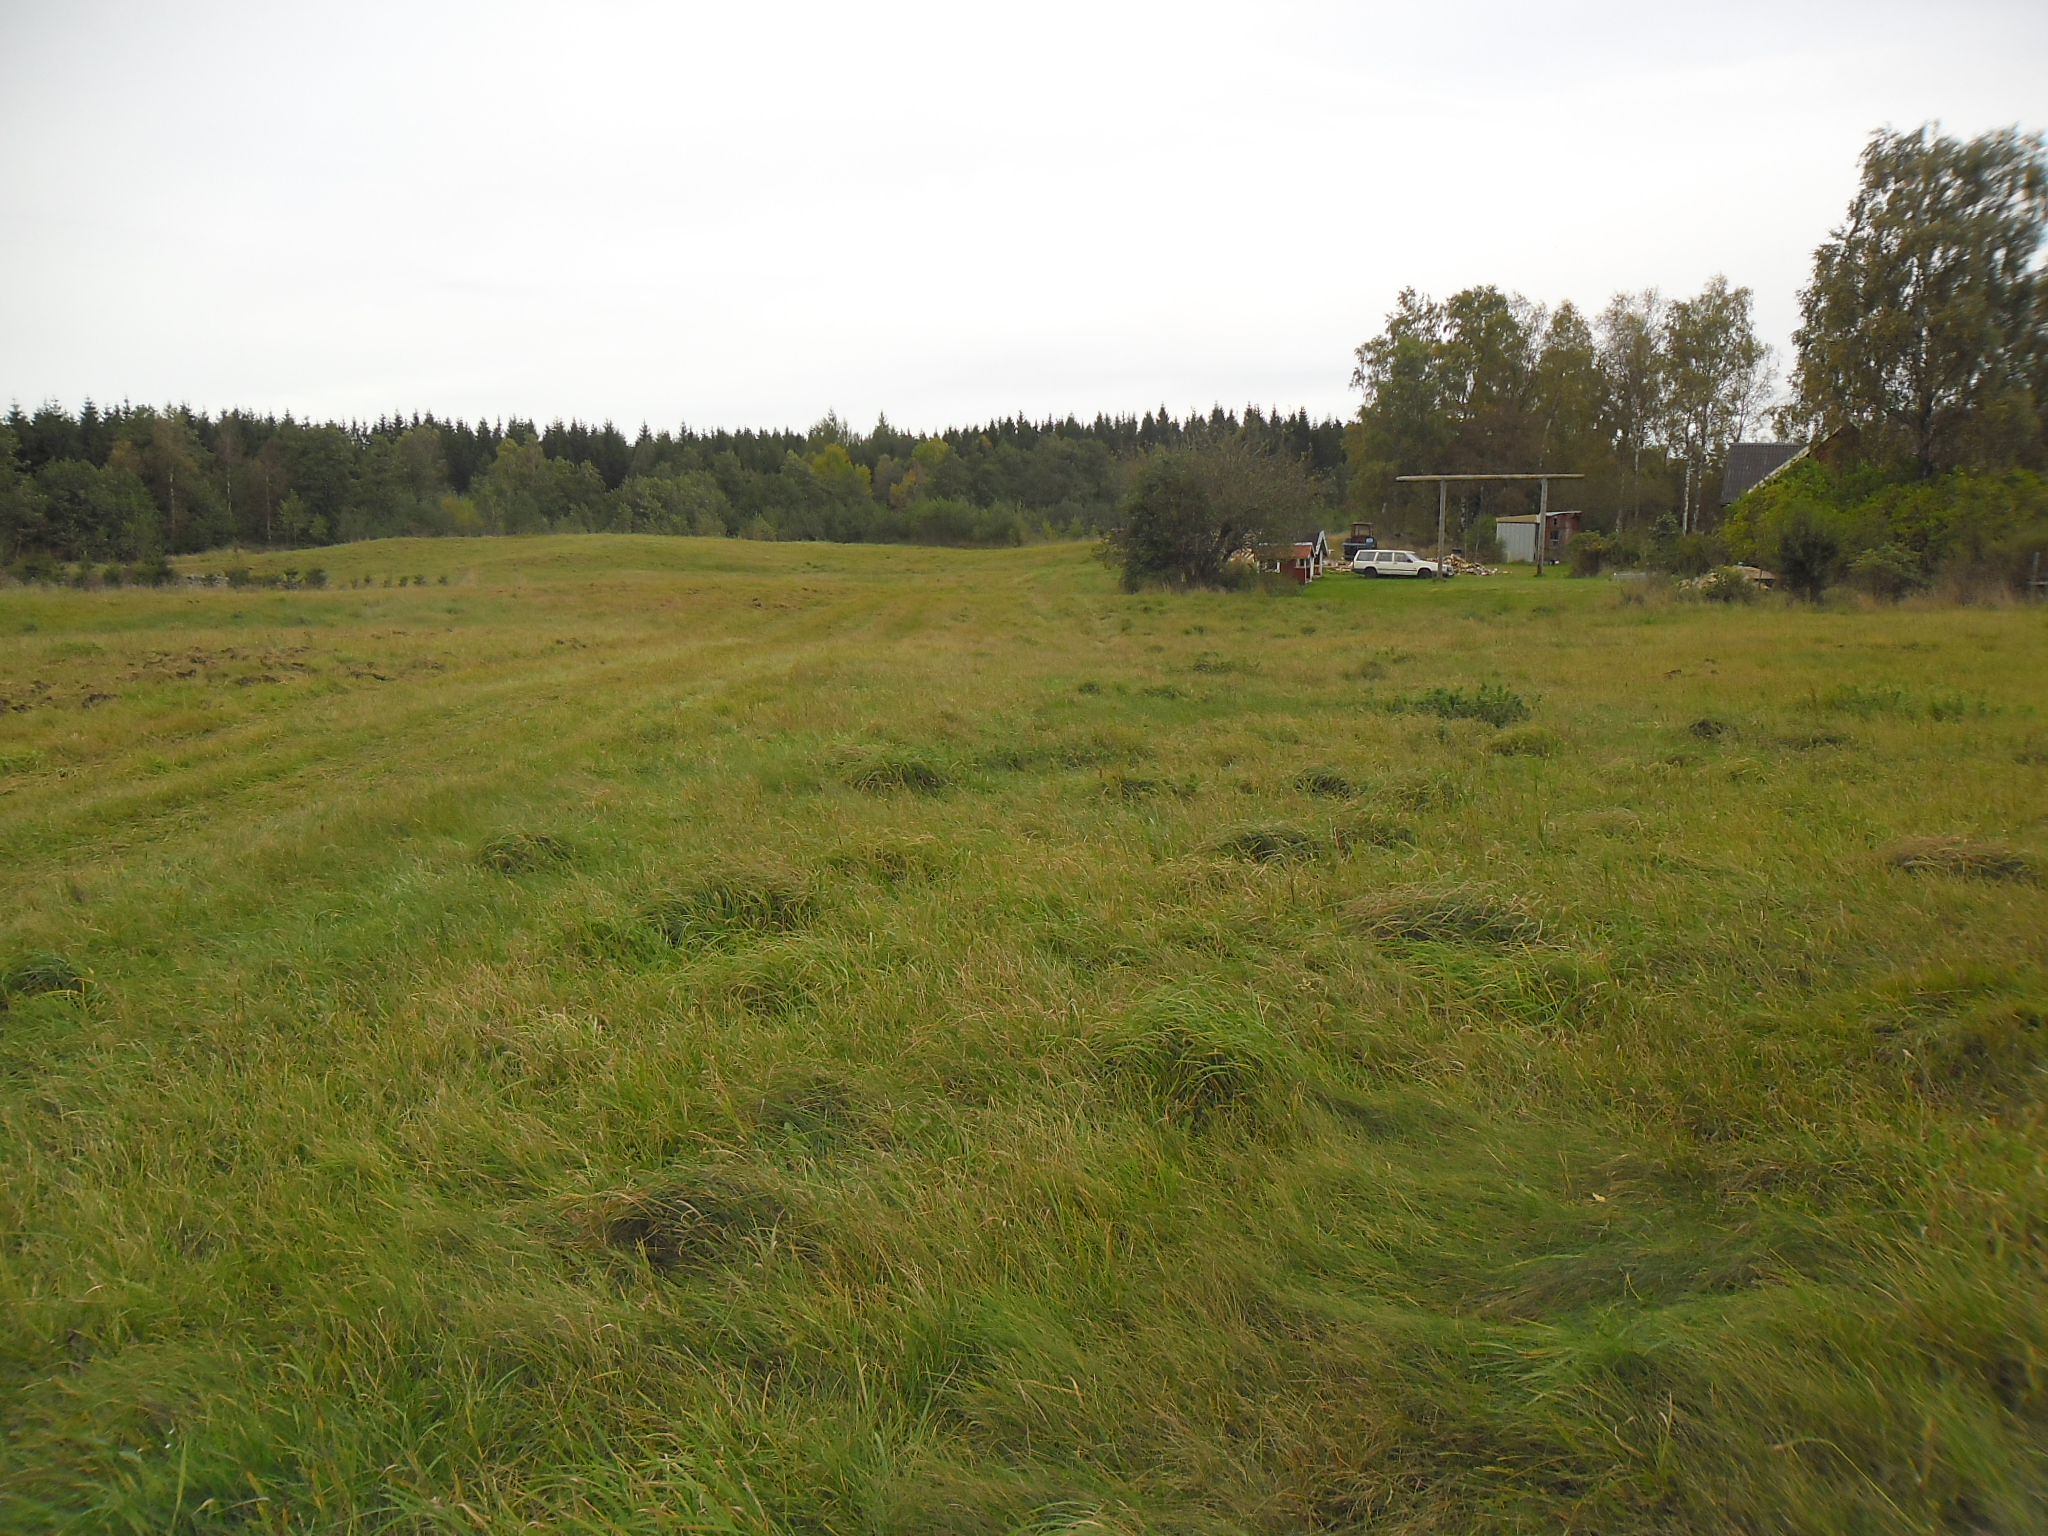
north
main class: Grassland
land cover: Grassland without tree/shrub cover
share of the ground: > 75 %
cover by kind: herbaceous plants 100 %
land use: Agriculture (excluding fallow land and kitchen gardens)
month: October
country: SE
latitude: 56.5617
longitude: 13.2025
